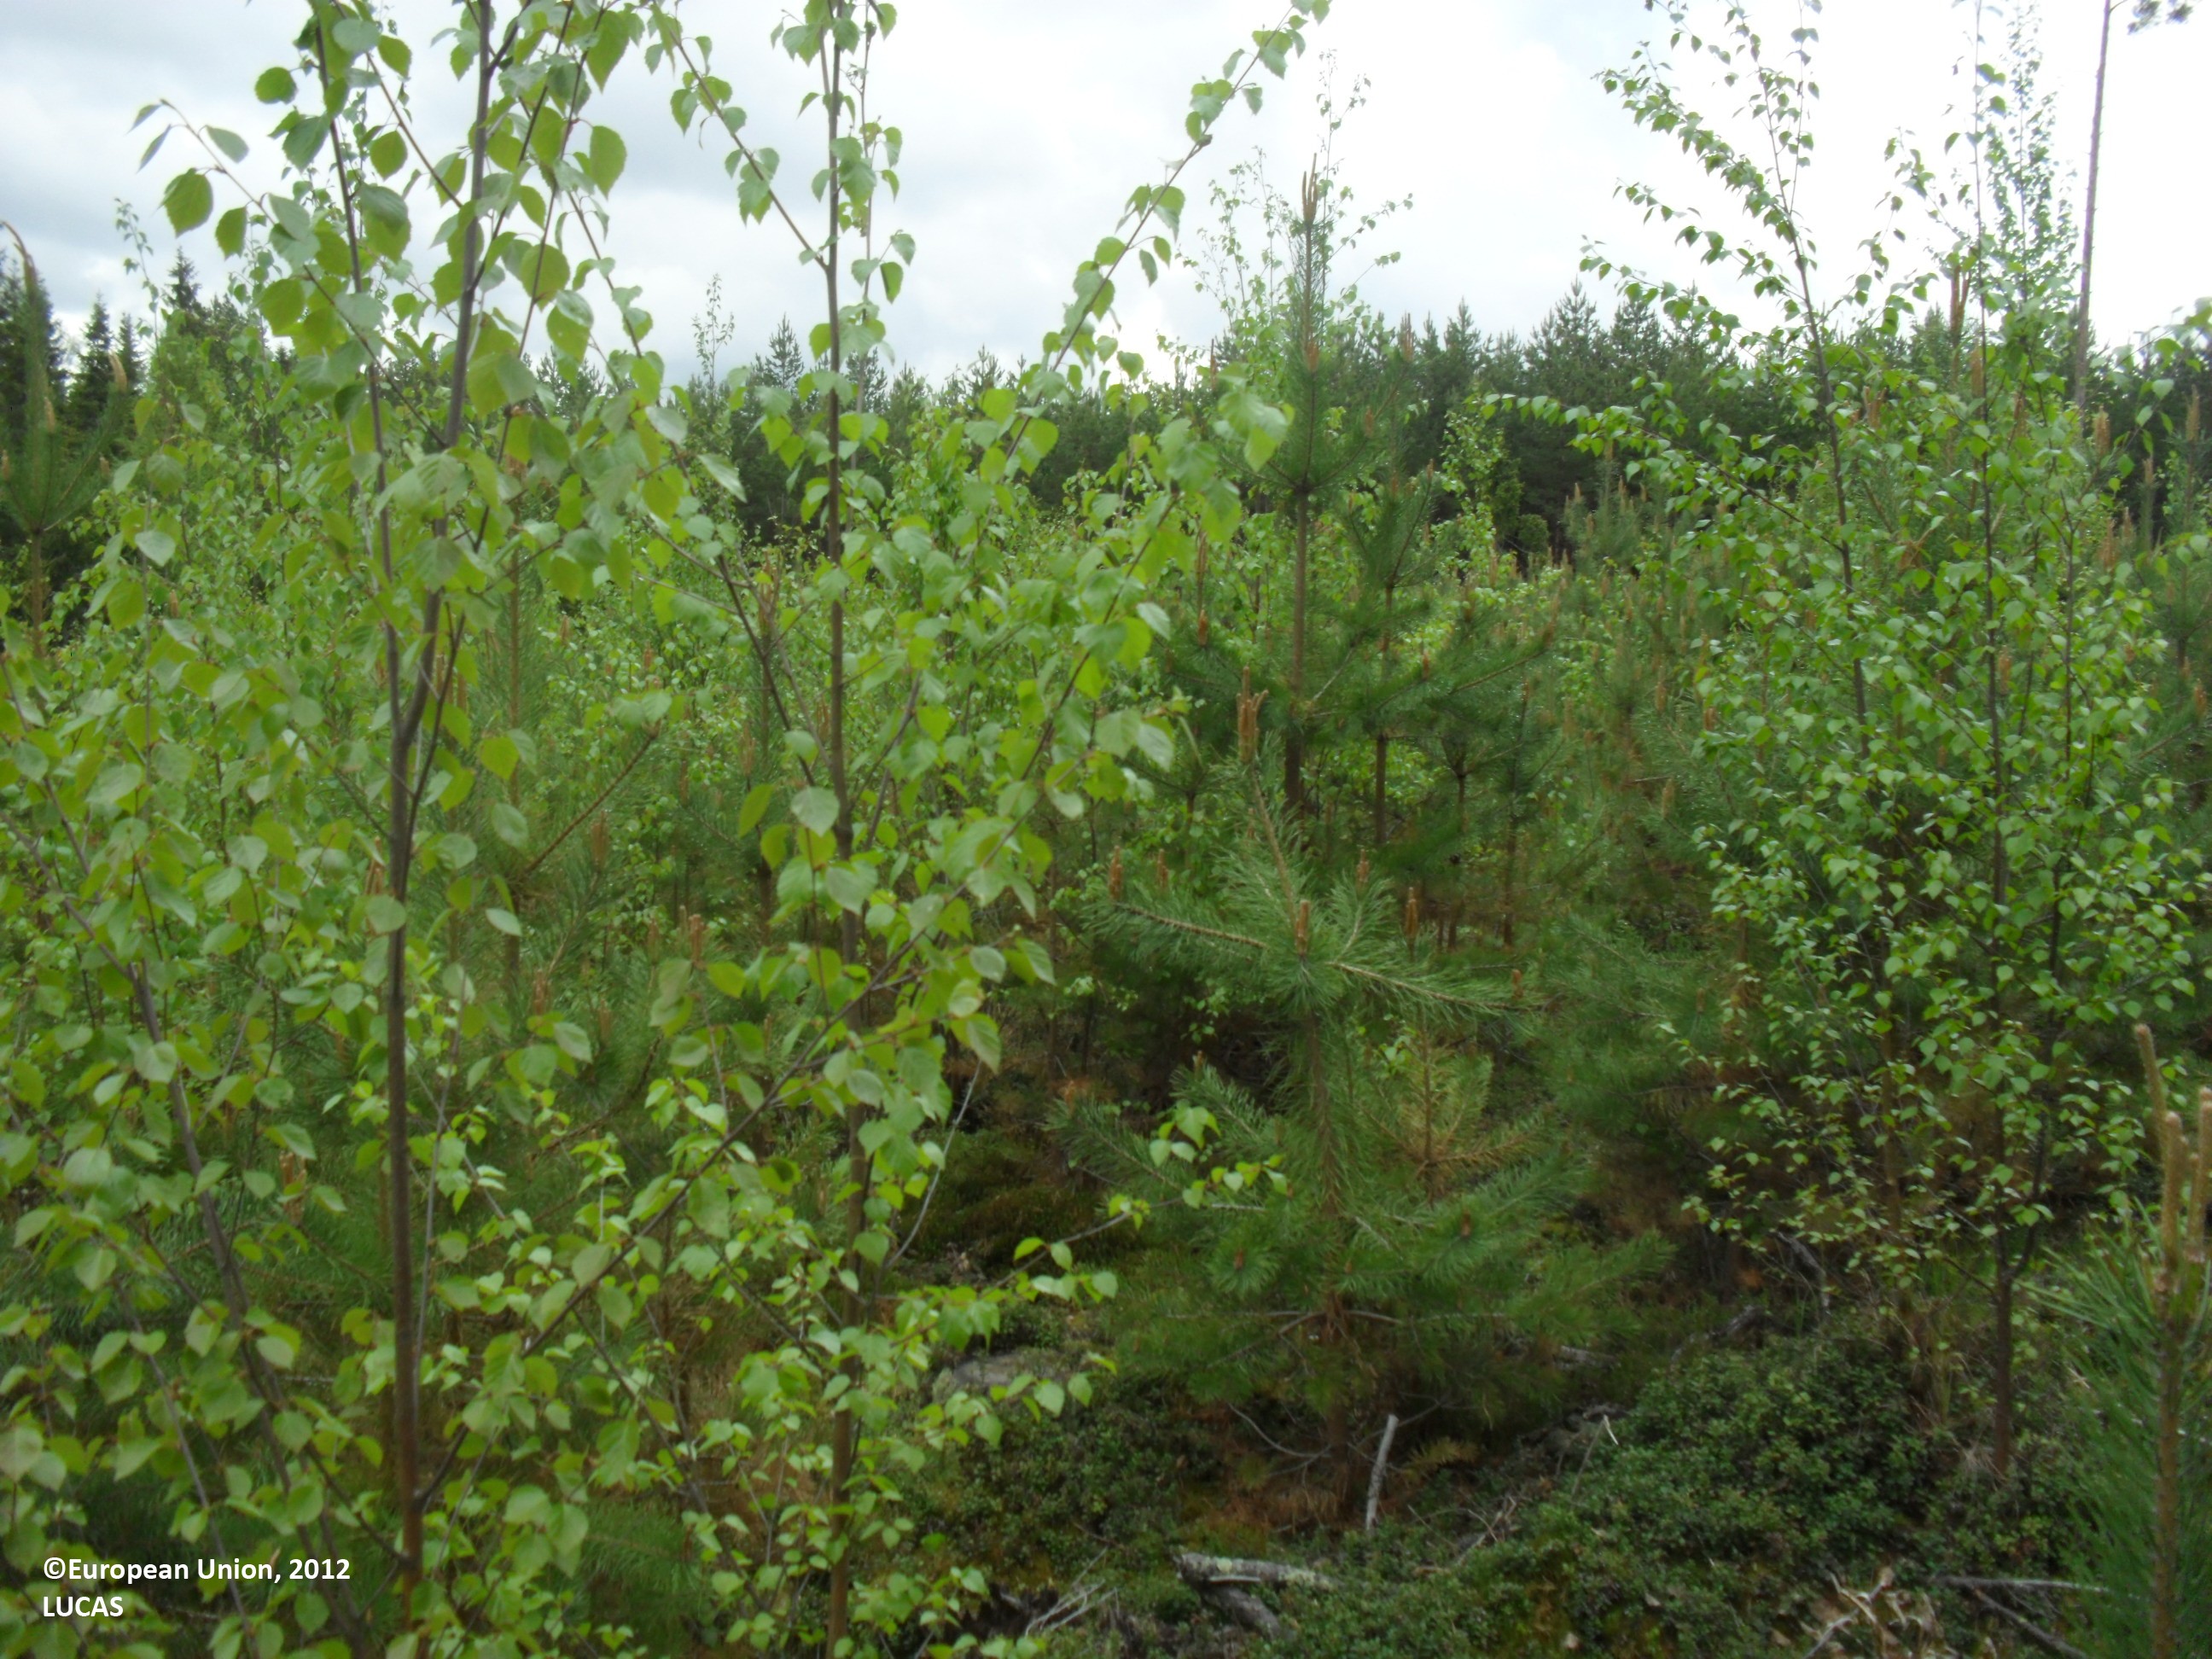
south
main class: Woodland
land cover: Pine dominated mixed woodland
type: boreal forest
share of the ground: < 10 %
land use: Forestry
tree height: < 5 m
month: June
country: FI
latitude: 62.7953
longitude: 23.0207
